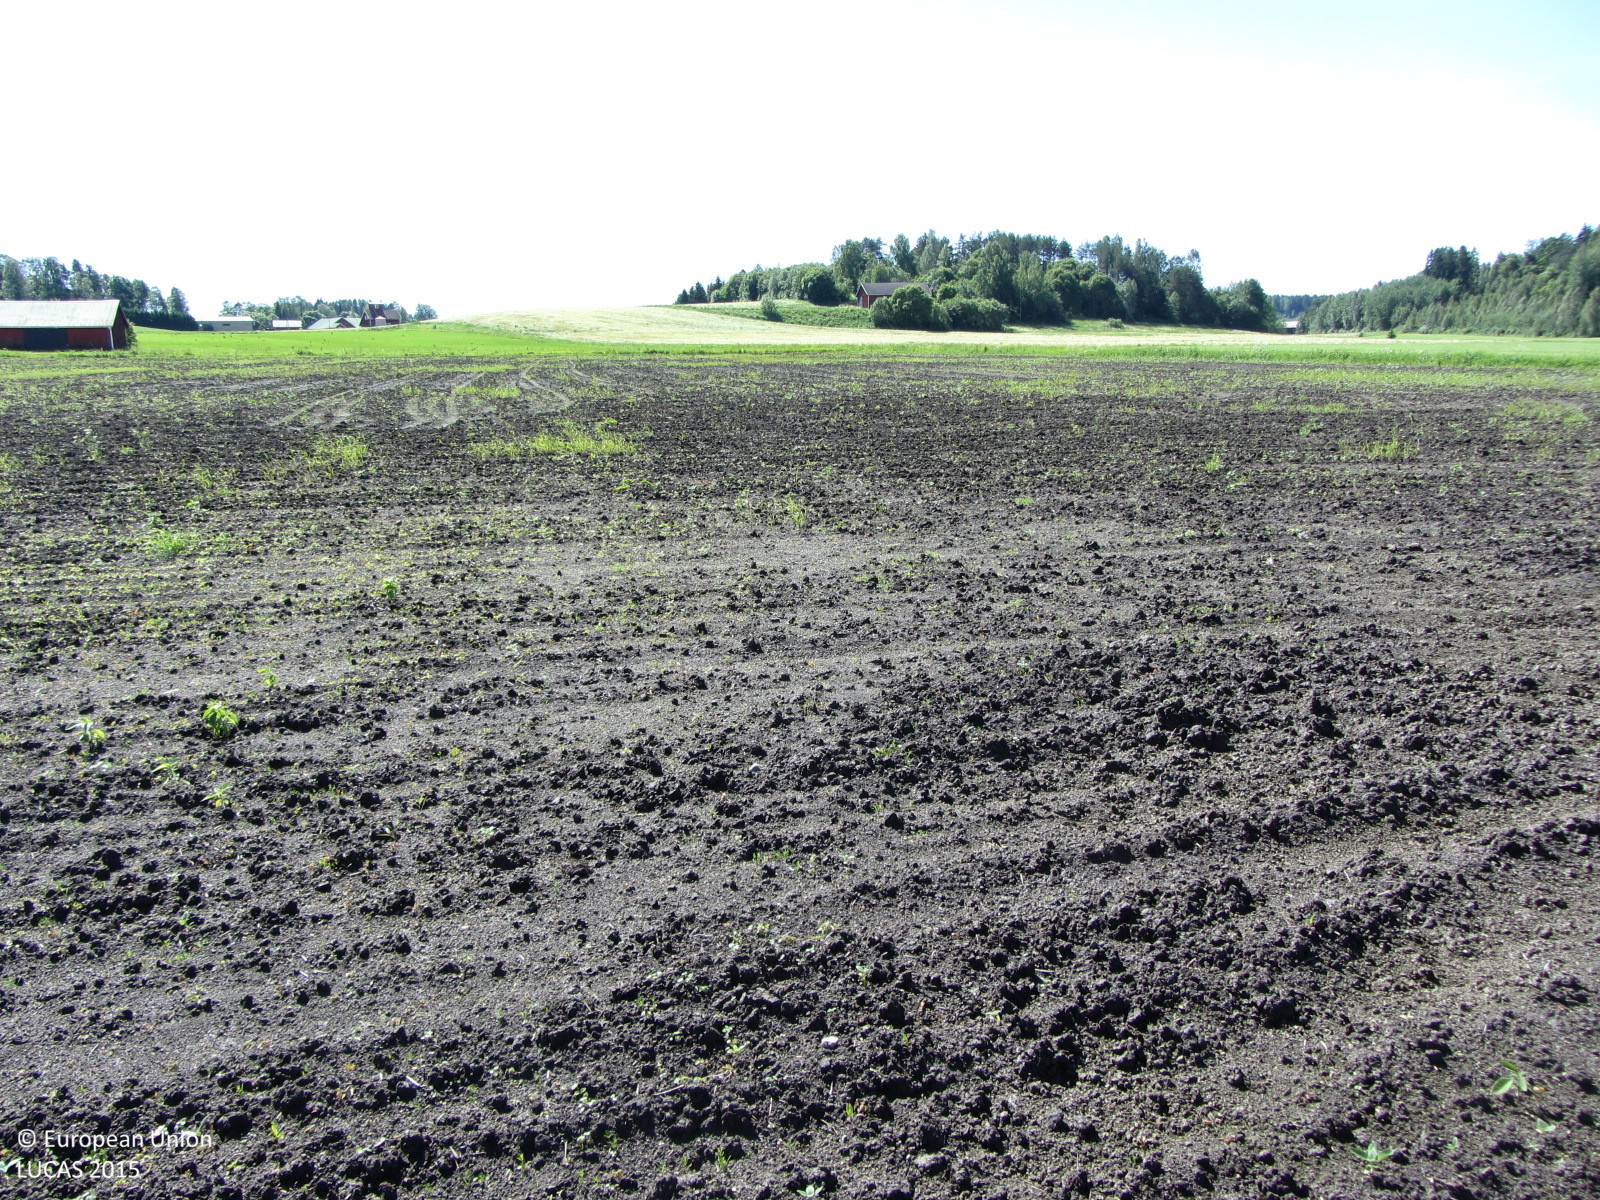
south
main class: Cropland
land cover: Other non-permanent industrial crops
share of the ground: 25 - 50 %
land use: Agriculture (excluding fallow land and kitchen gardens)
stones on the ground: < 10 %
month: June
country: FI
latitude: 60.3383
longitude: 23.2533
